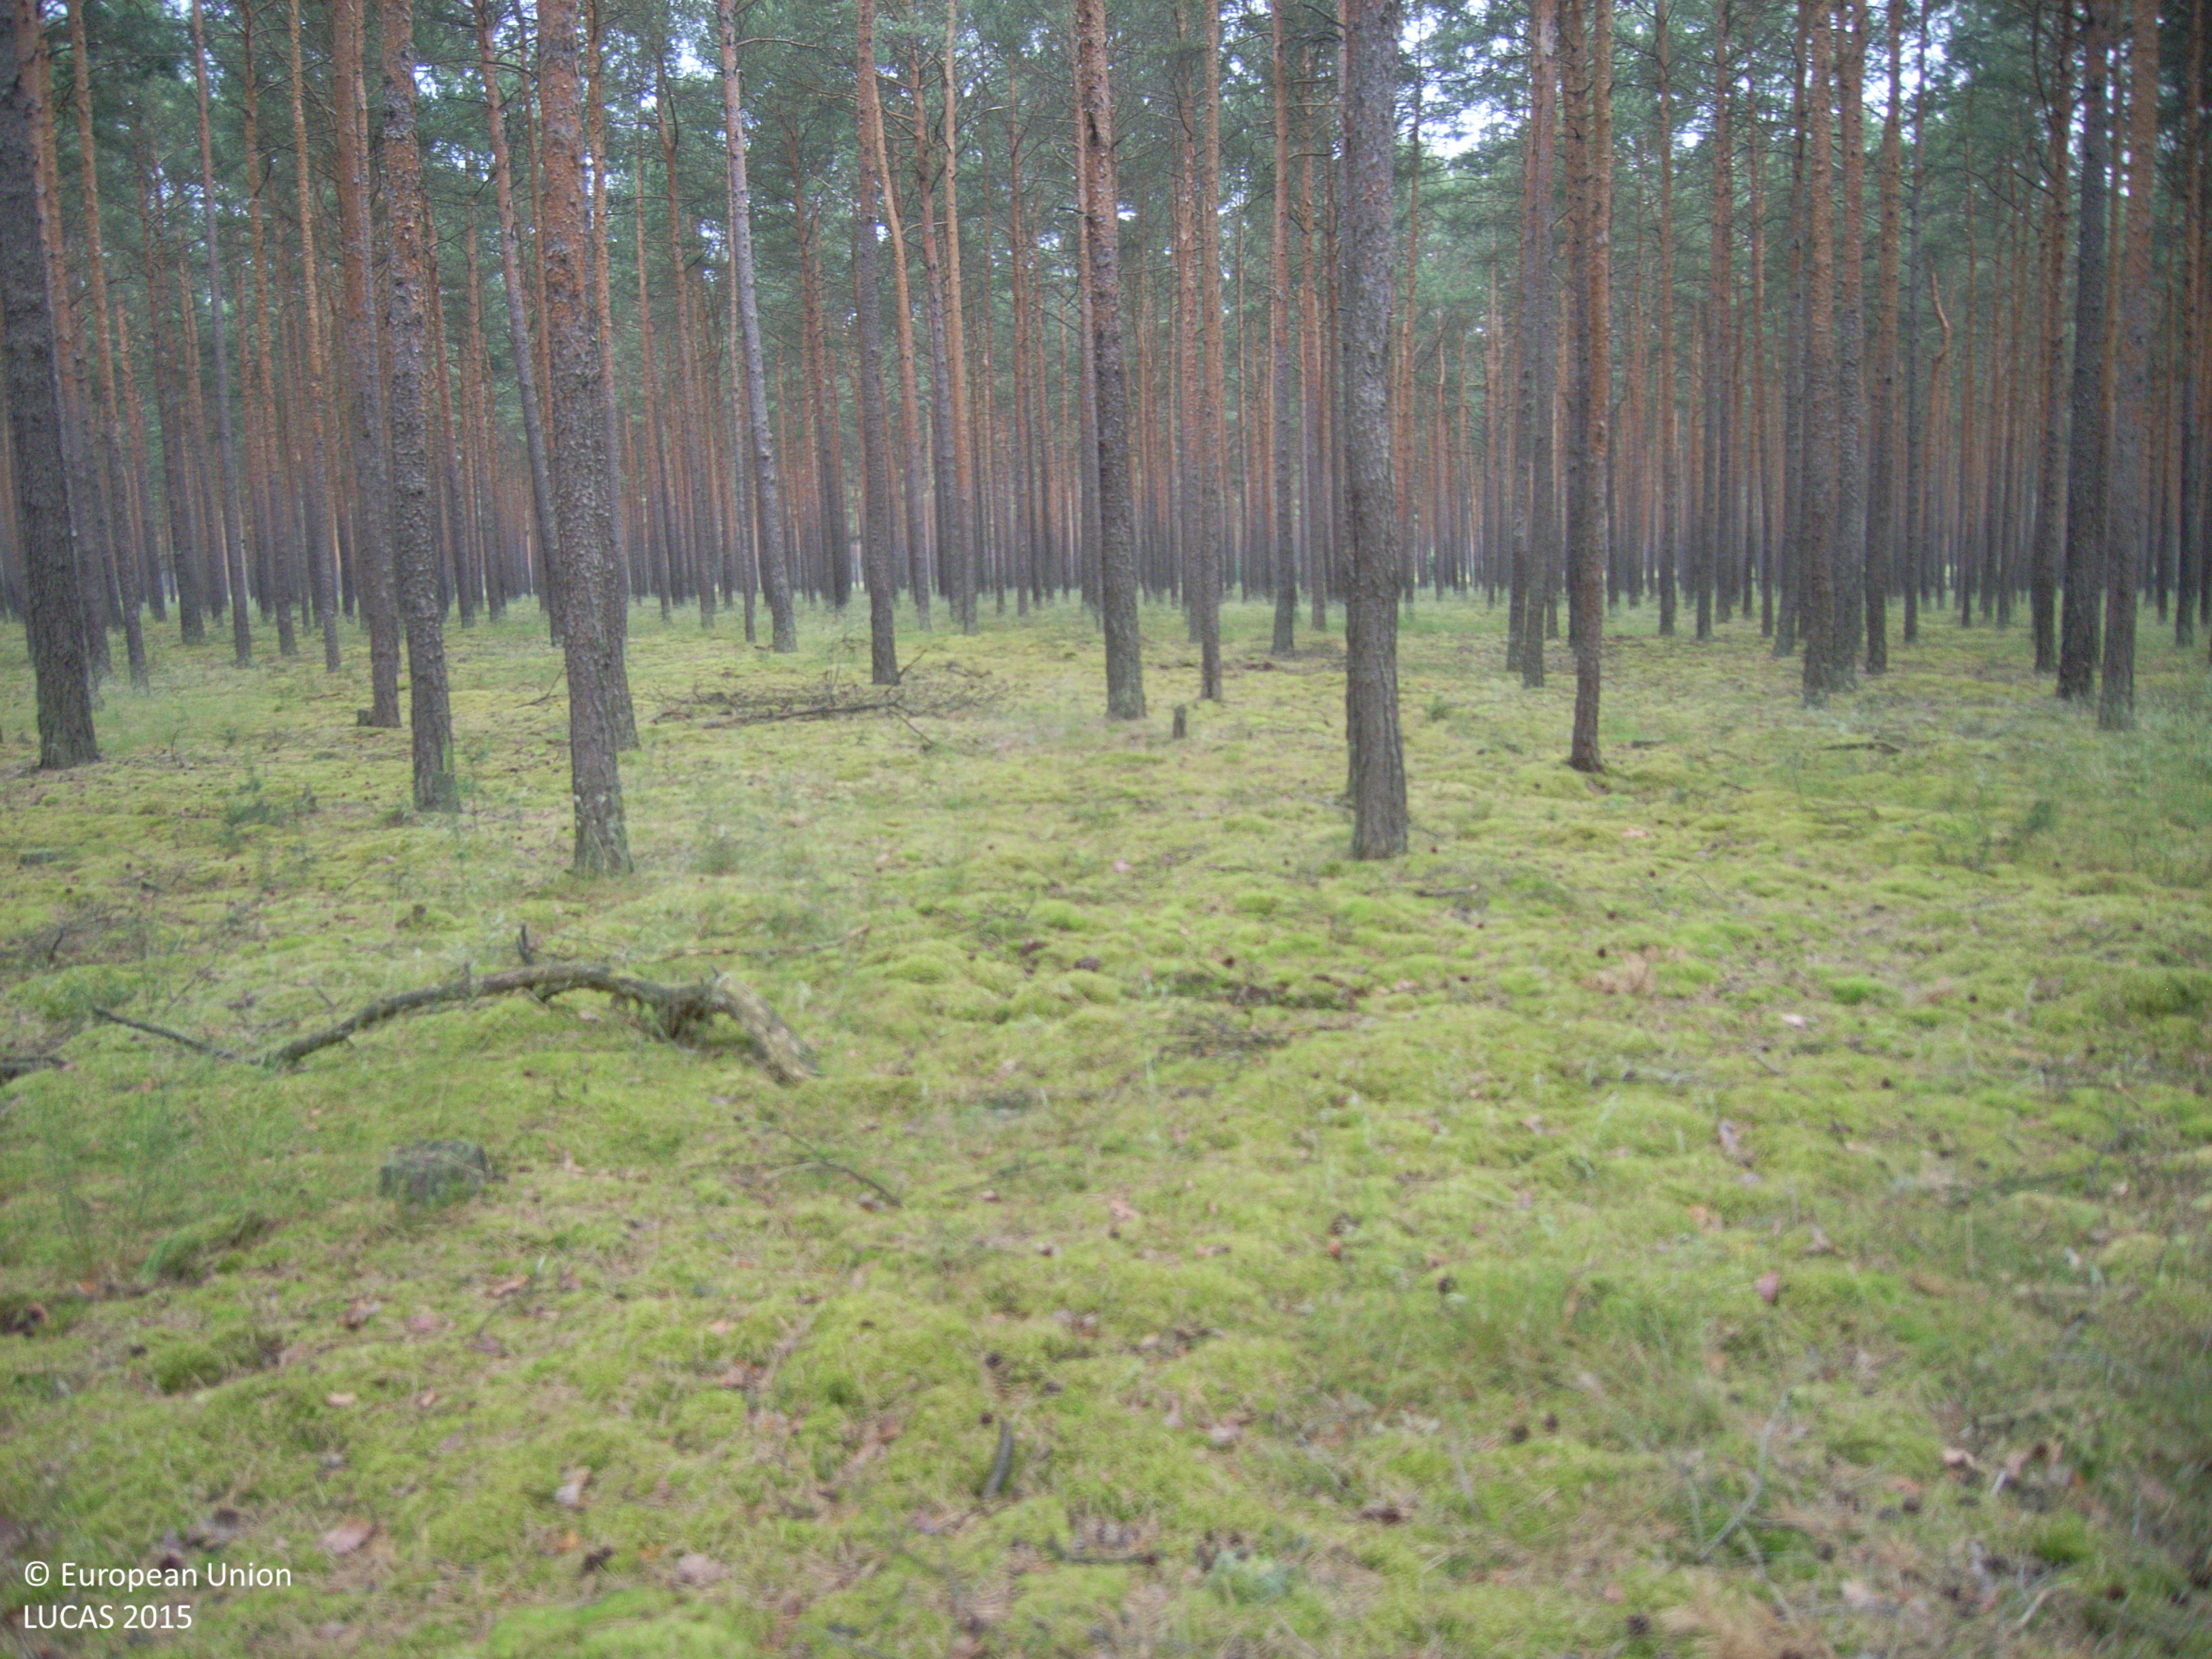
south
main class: Woodland
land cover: Pine dominated coniferous woodland
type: hemiboreal forest and nemoral coniferous forest and mixed broadleaved-coniferous forest
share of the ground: > 75 %
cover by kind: coniferous forest trees 100 %
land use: Forestry
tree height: > 5 m
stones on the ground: < 10 %
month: June
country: DE
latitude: 52.0443
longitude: 14.3902
